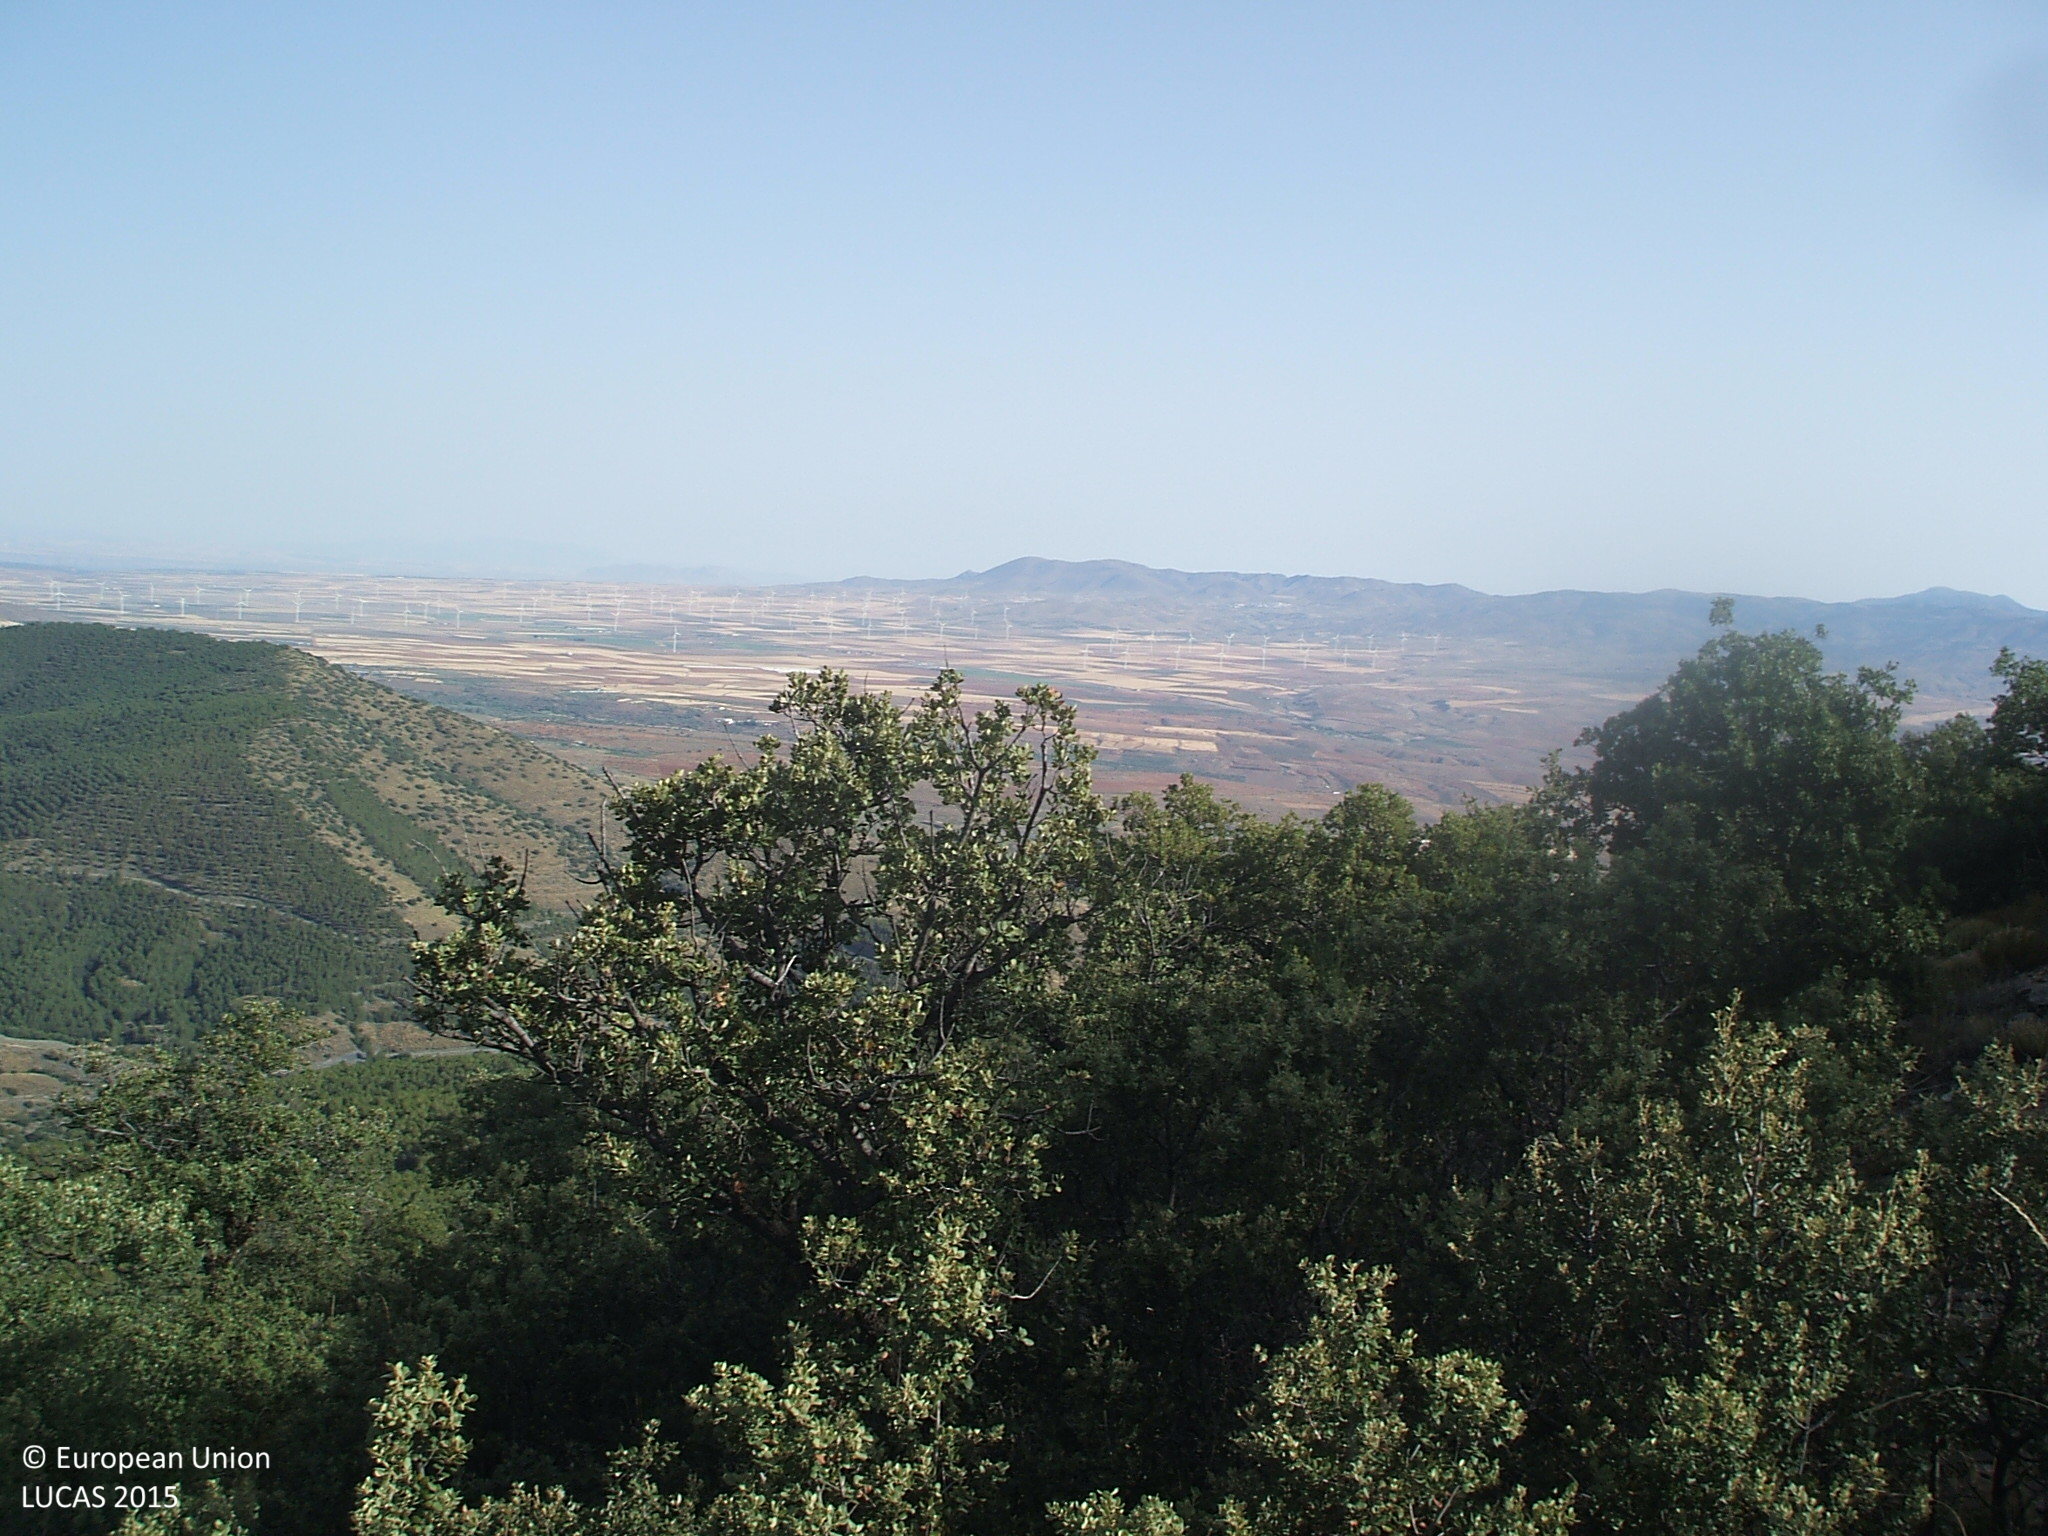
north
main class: Woodland
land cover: Broadleaved woodland
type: broadleaved evergreen forest
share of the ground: 10 - 25 %
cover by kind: shrubs 80 %, broadleaved forest trees 20 %
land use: Semi-natural and natural areas not in use
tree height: < 5 m
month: June
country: ES
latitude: 37.1407
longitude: -2.8954
